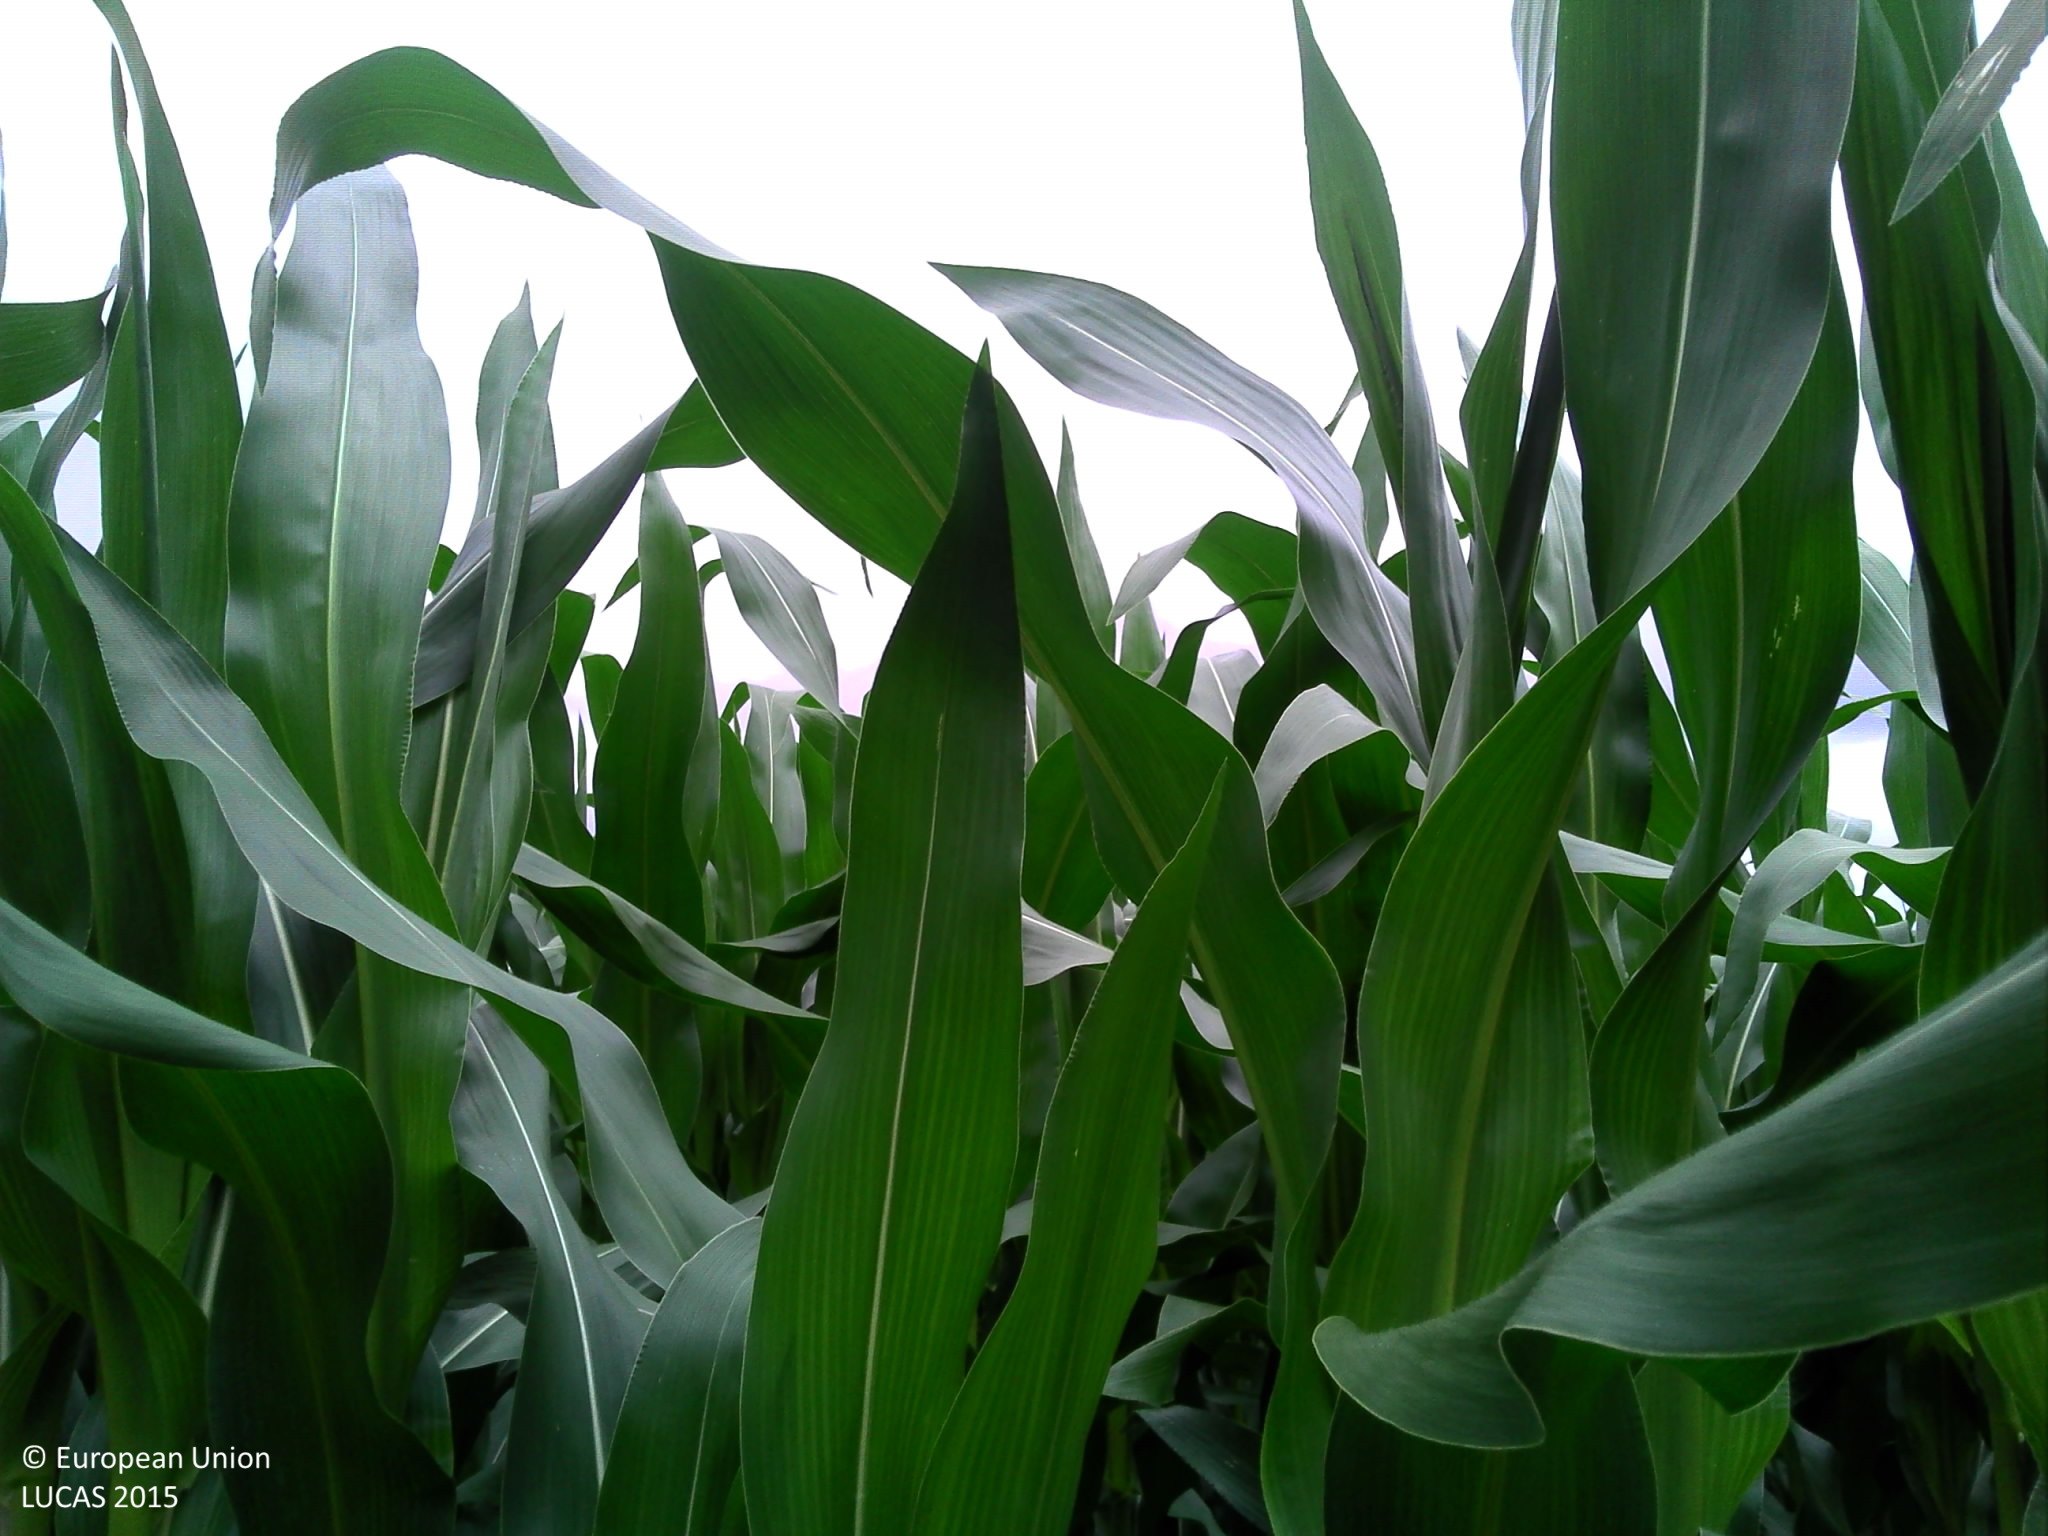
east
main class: Cropland
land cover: Maize
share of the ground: 50 - 75 %
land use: Agriculture (excluding fallow land and kitchen gardens)
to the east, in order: Maize
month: July
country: FR
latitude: 48.2090
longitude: -2.4263
